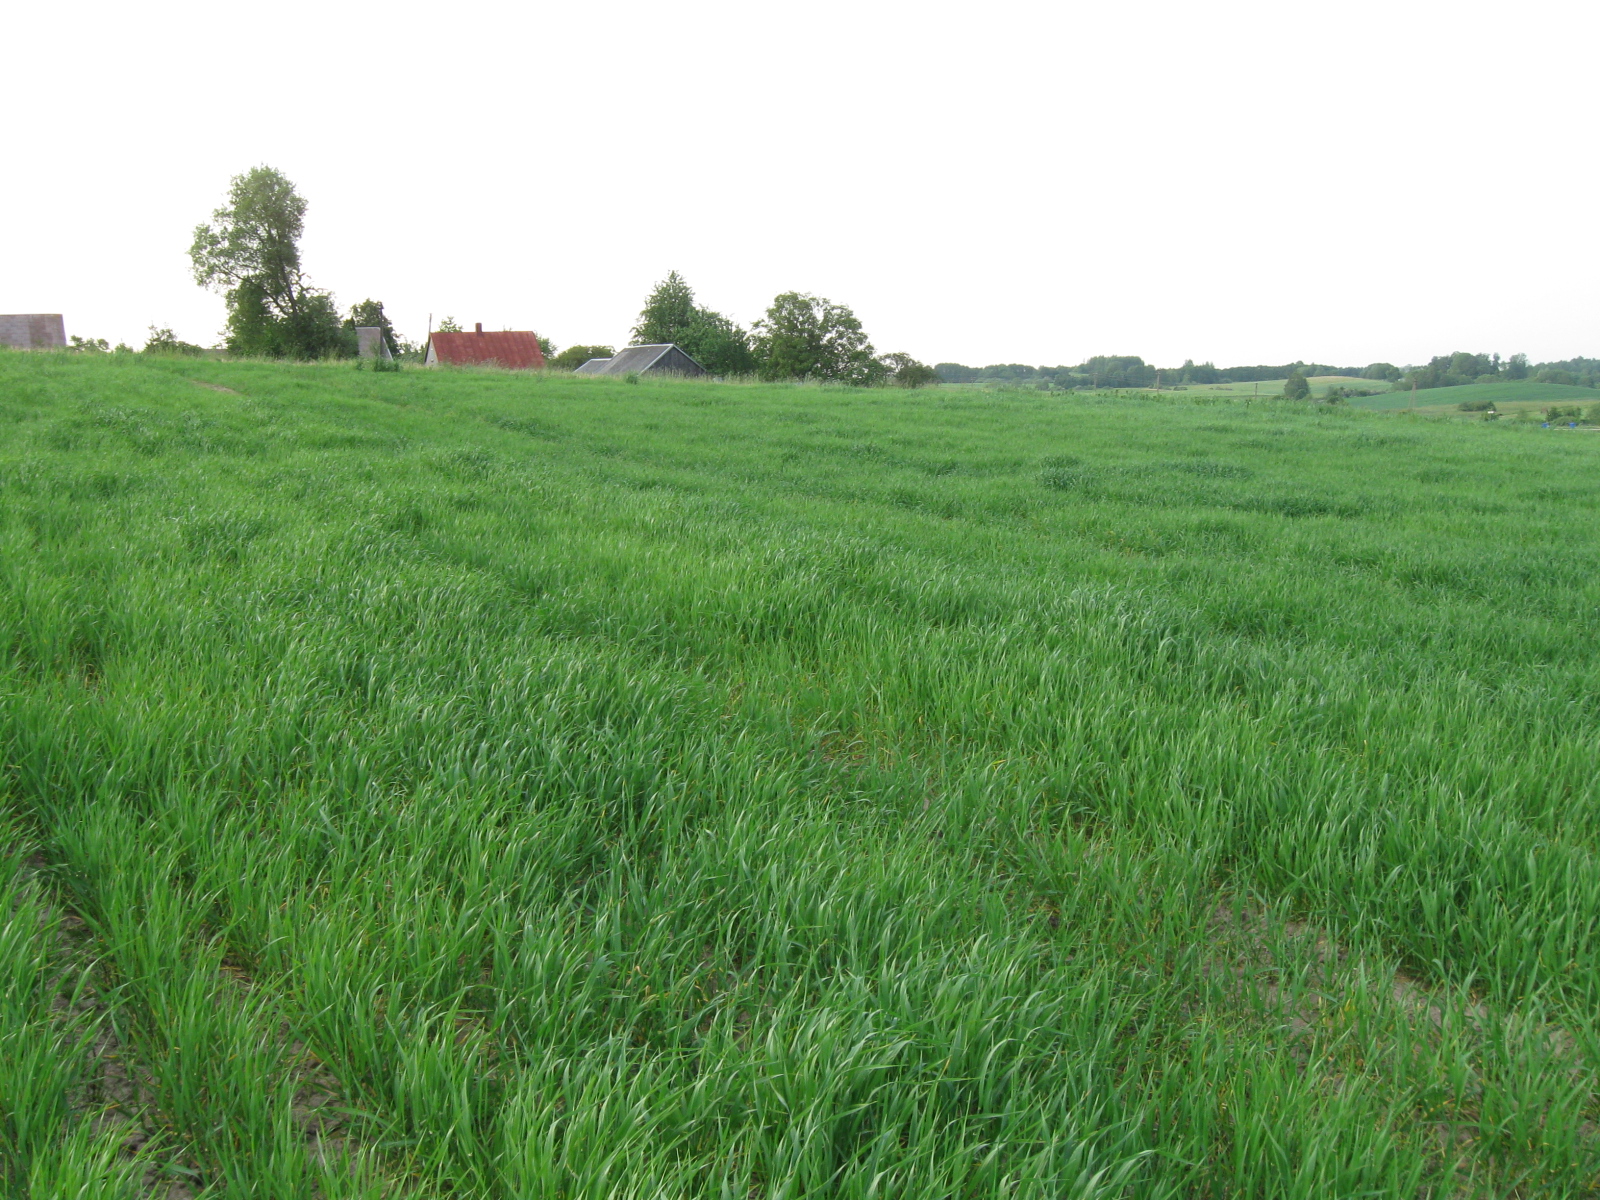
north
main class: Cropland
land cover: Barley
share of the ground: > 75 %
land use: Agriculture (excluding fallow land and kitchen gardens)
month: June
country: LT
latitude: 54.2675
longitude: 23.6431
